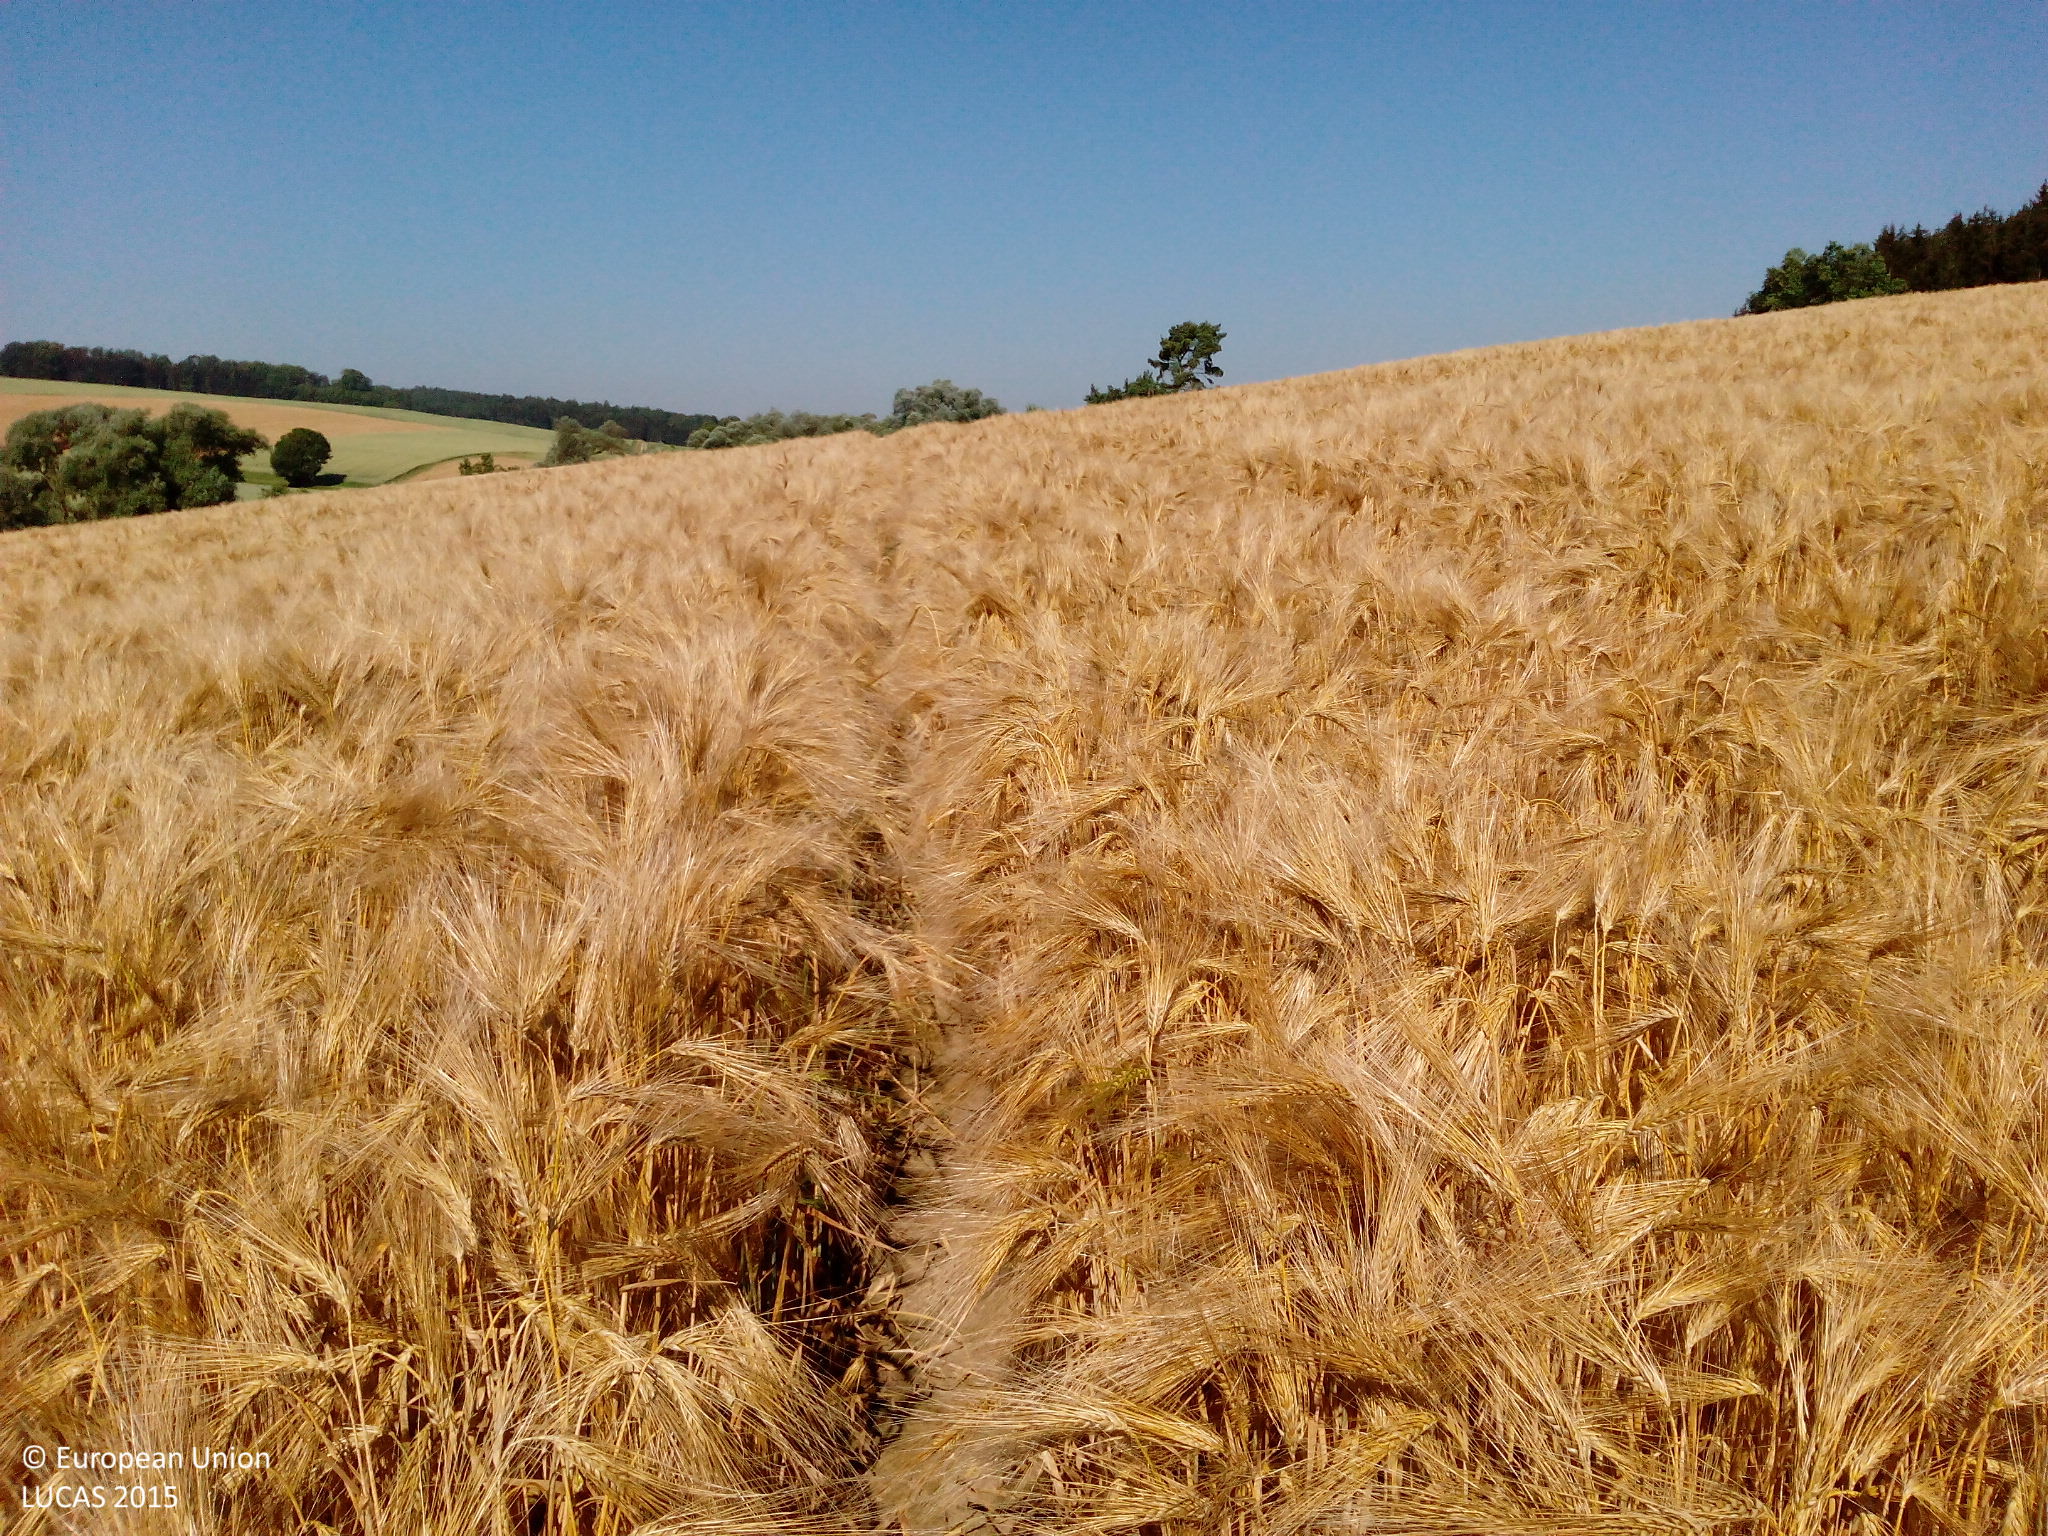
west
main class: Cropland
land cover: Barley
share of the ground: > 75 %
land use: Agriculture (excluding fallow land and kitchen gardens)
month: July
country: DE
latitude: 48.7958
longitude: 10.8844
